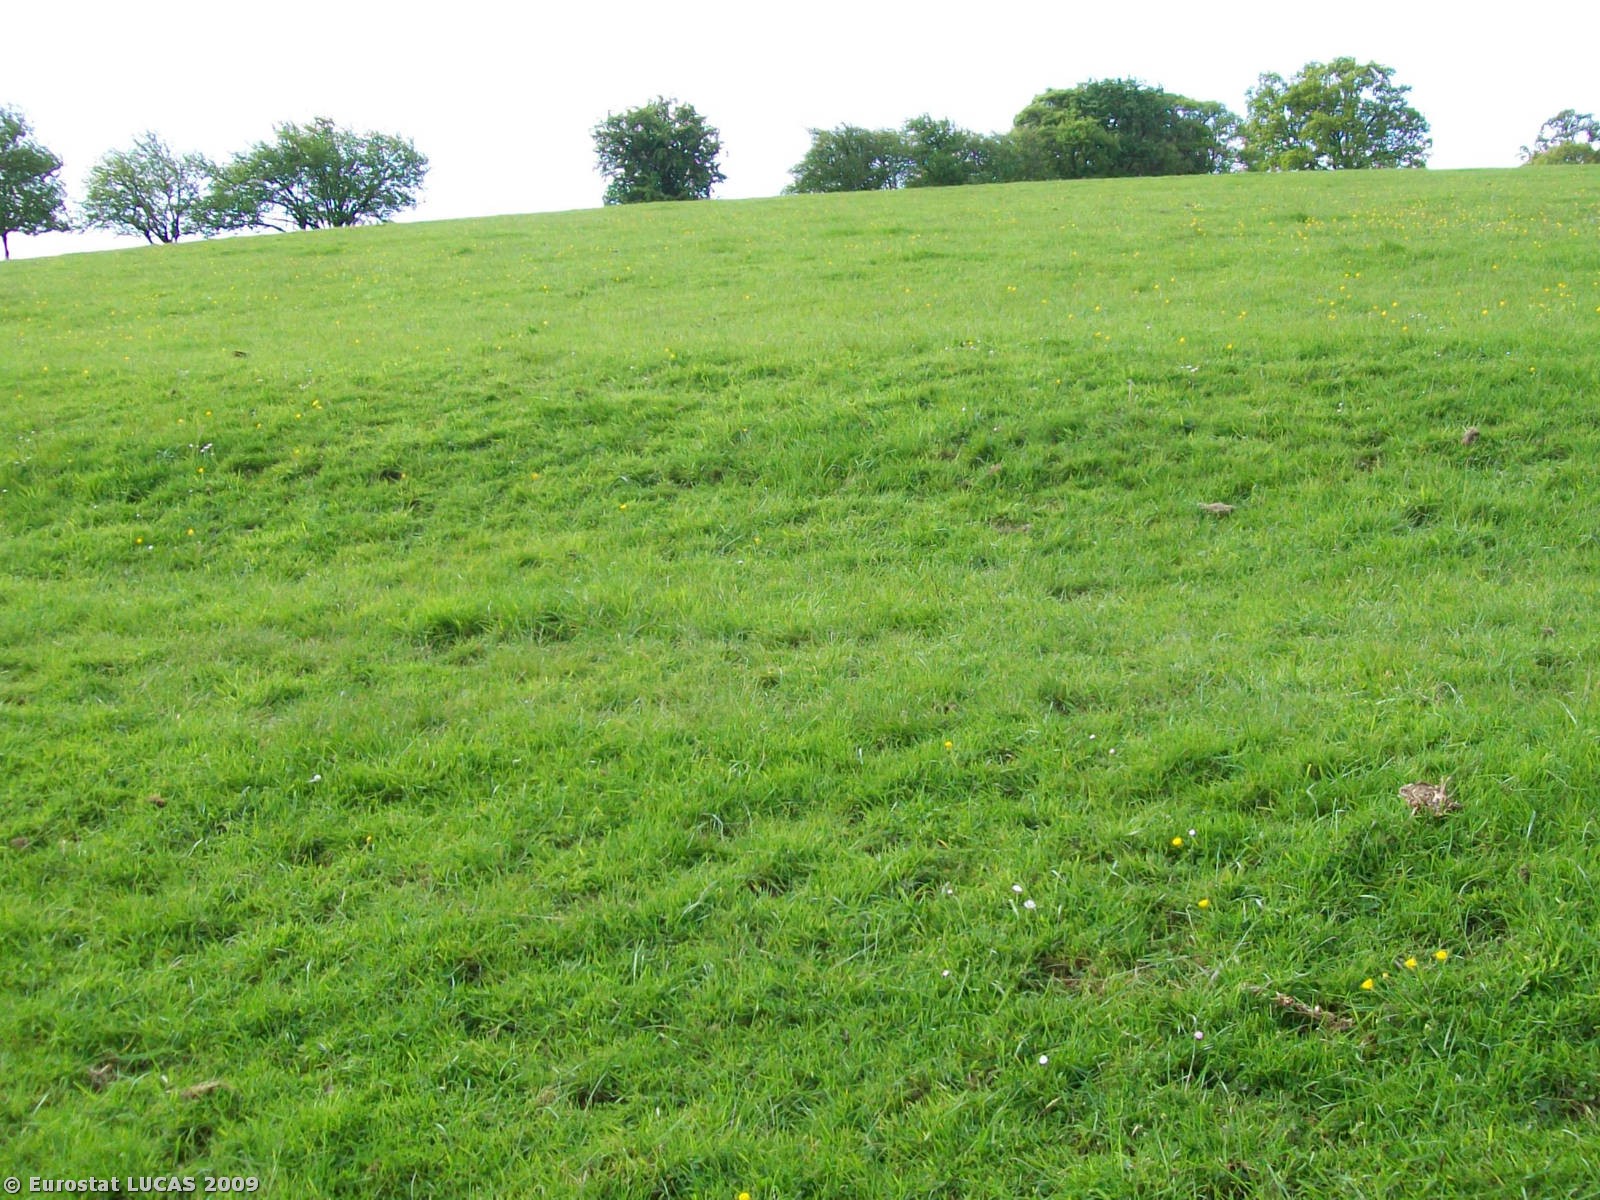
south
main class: Grassland
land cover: Grassland without tree/shrub cover
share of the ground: > 75 %
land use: Agriculture (excluding fallow land and kitchen gardens)
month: May
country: GB
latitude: 52.2974
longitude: -2.4860
